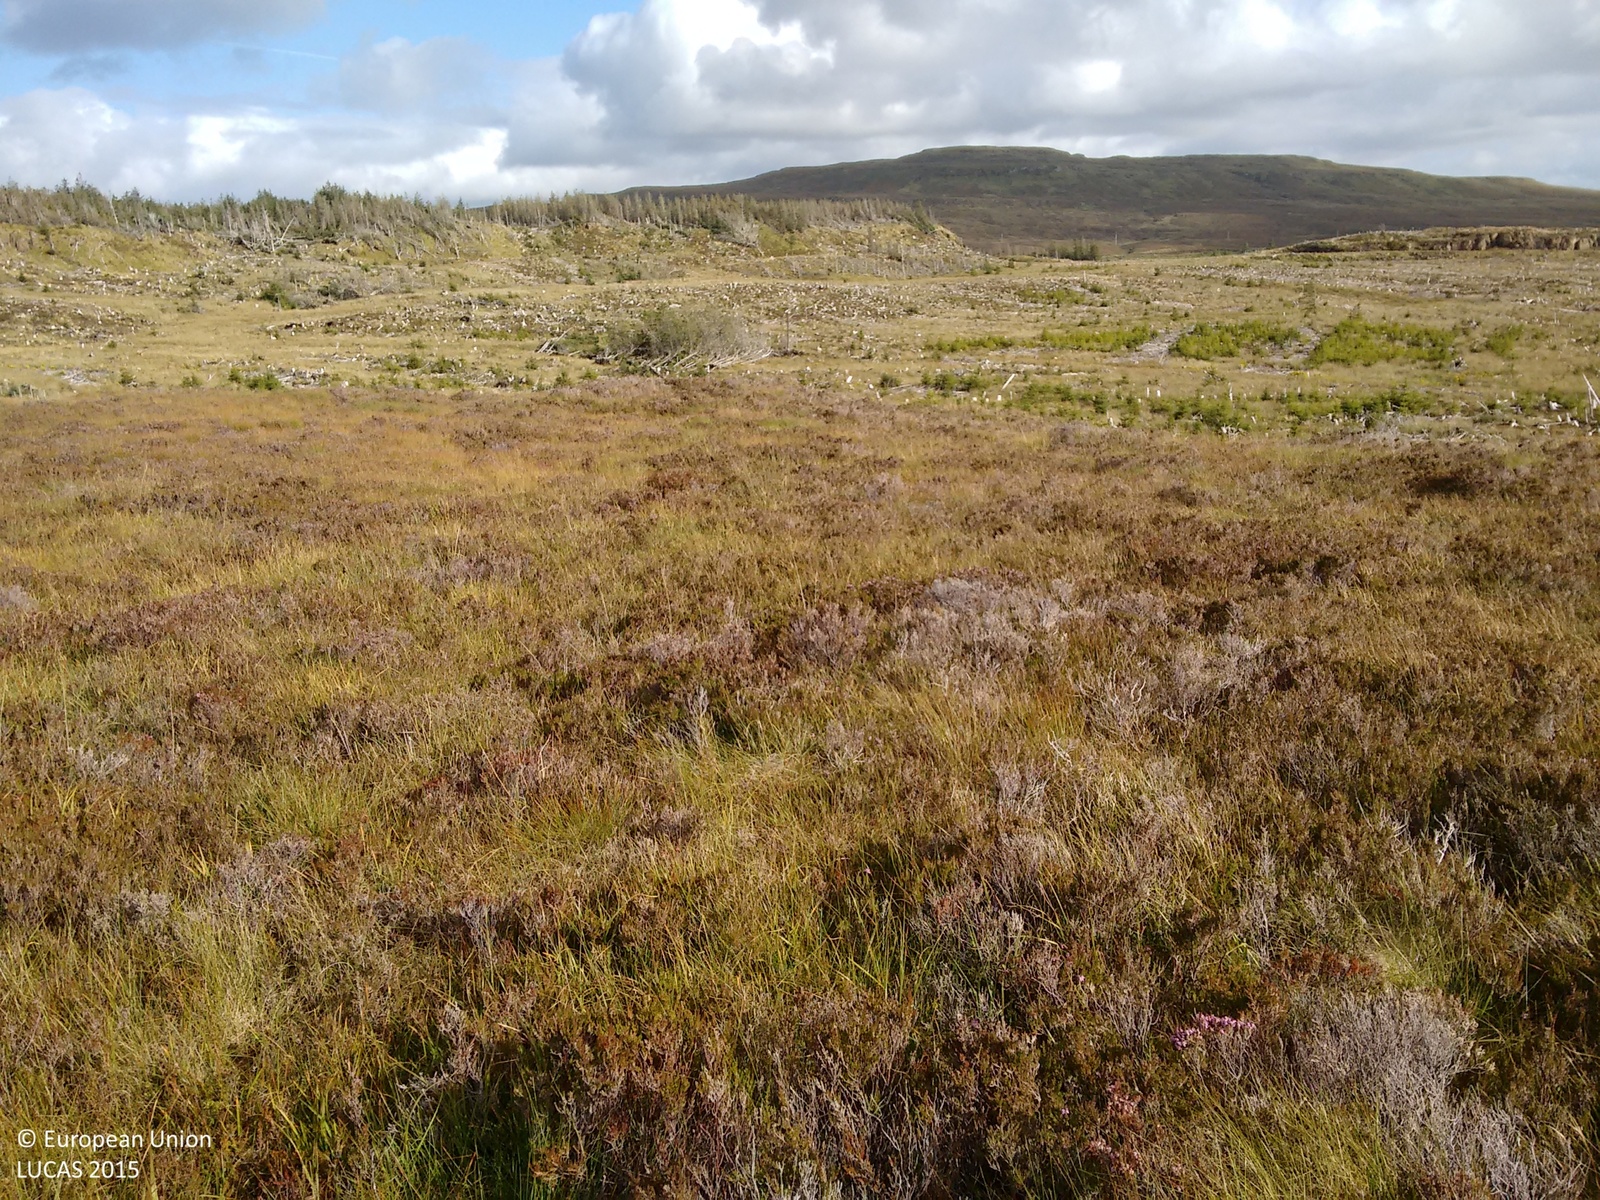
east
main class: Shrubland
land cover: Shrubland without tree cover
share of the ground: > 75 %
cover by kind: shrubs 90 %, herbaceous plants 10 %
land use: Semi-natural and natural areas not in use
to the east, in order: Shrubland without tree cover; Tracks; Fences; Spontaneously vegetated surfaces; Spruce dominated coniferous woodland; Spontaneously vegetated surfaces
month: September
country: GB
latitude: 57.4570
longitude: -6.5623
